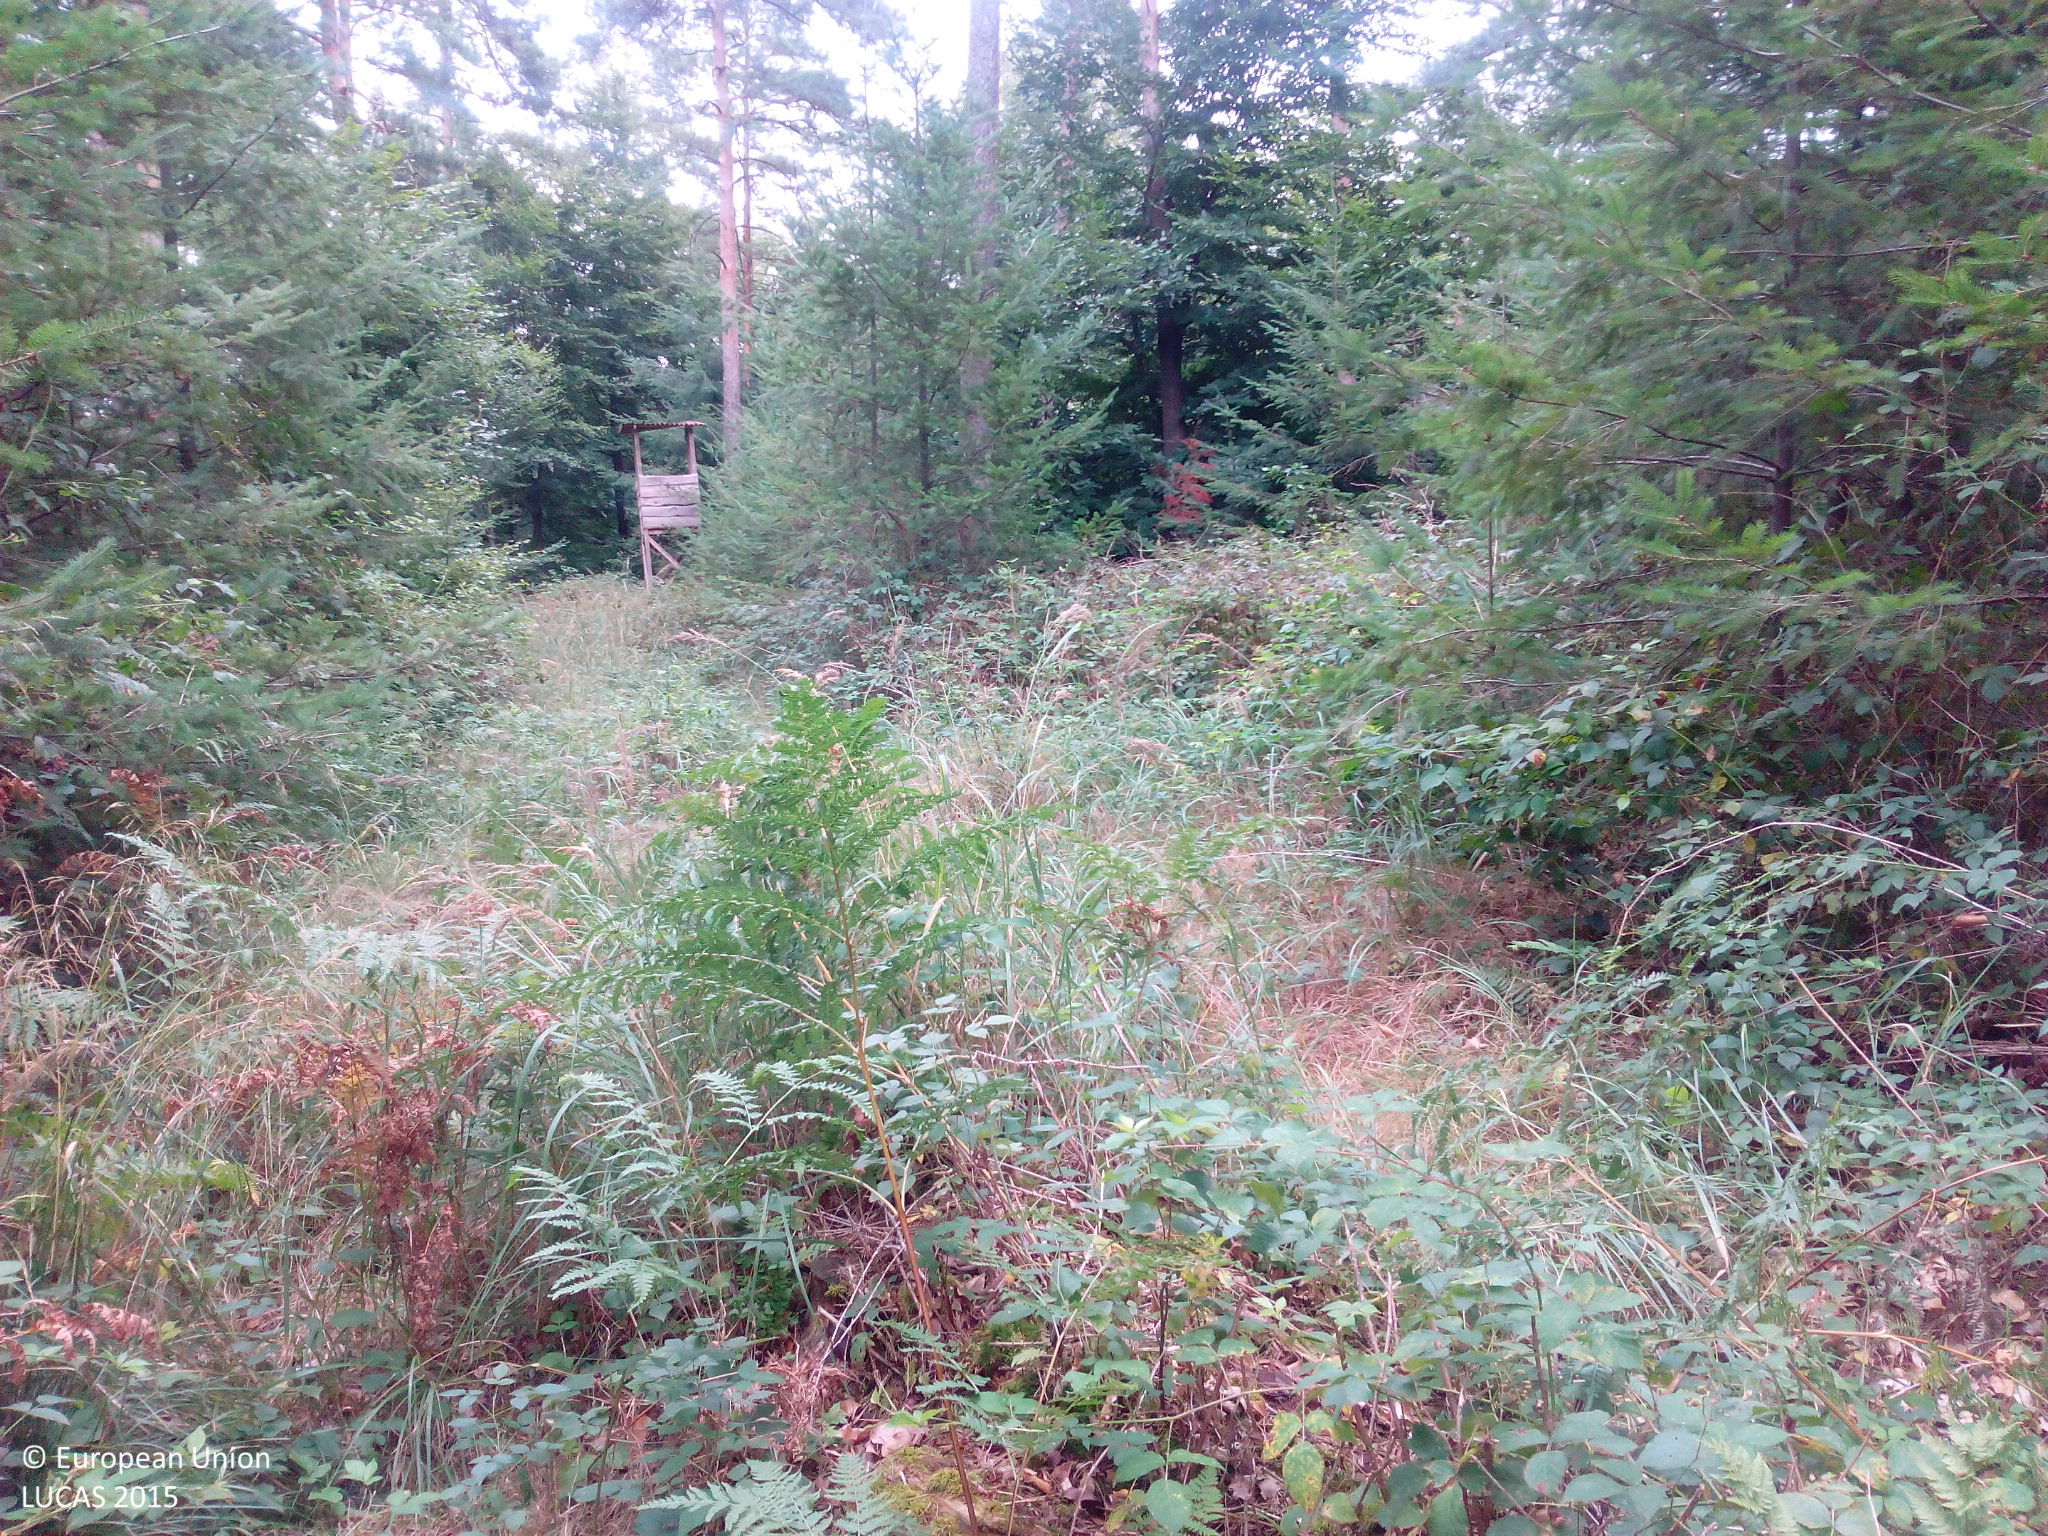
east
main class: Woodland
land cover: Pine dominated coniferous woodland
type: hemiboreal forest and nemoral coniferous forest and mixed broadleaved-coniferous forest
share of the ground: > 75 %
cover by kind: coniferous forest trees 90 %, shrubs 10 %
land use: Forestry
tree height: > 5 m
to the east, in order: Pine dominated coniferous woodland; Tracks; Pine dominated mixed woodland; Tracks; Broadleaved woodland; Pine dominated mixed woodland
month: August
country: DE
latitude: 51.7024
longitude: 12.5609
